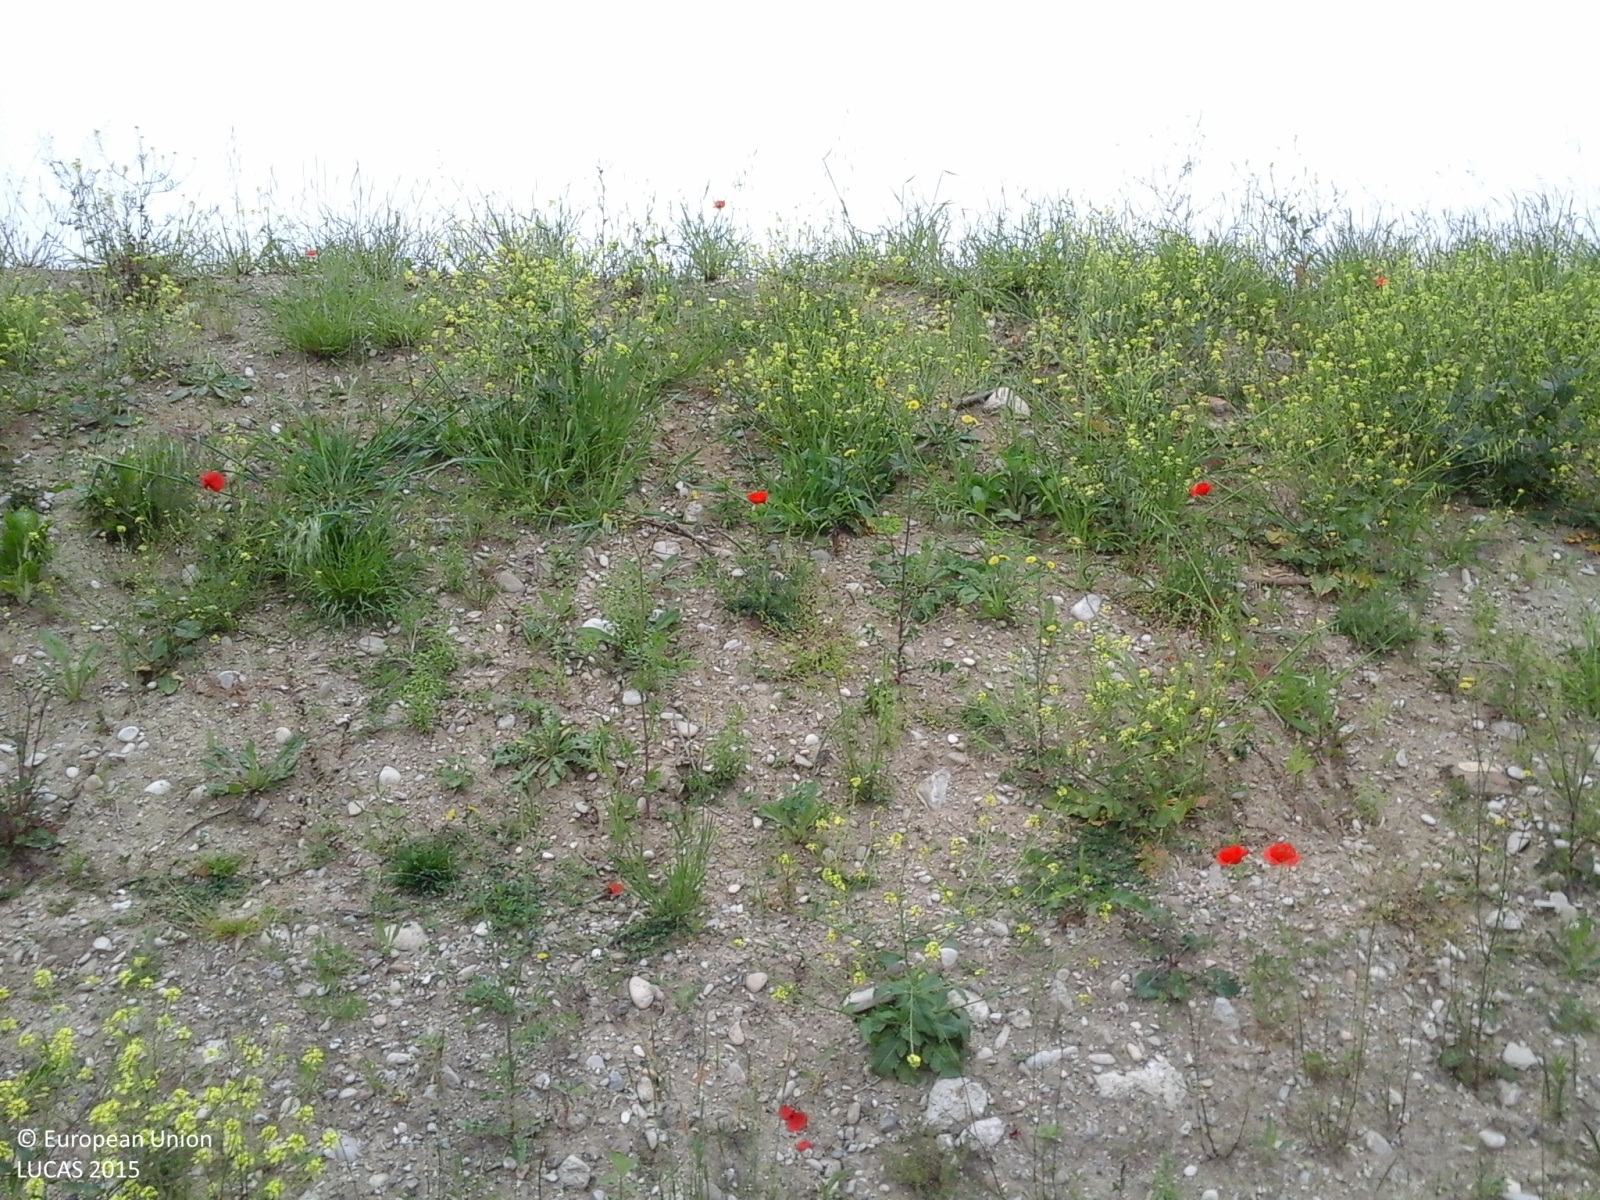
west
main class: Cropland
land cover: Common wheat
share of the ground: > 75 %
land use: Agriculture (excluding fallow land and kitchen gardens)
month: May
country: IT
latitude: 44.1050
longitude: 12.4555
